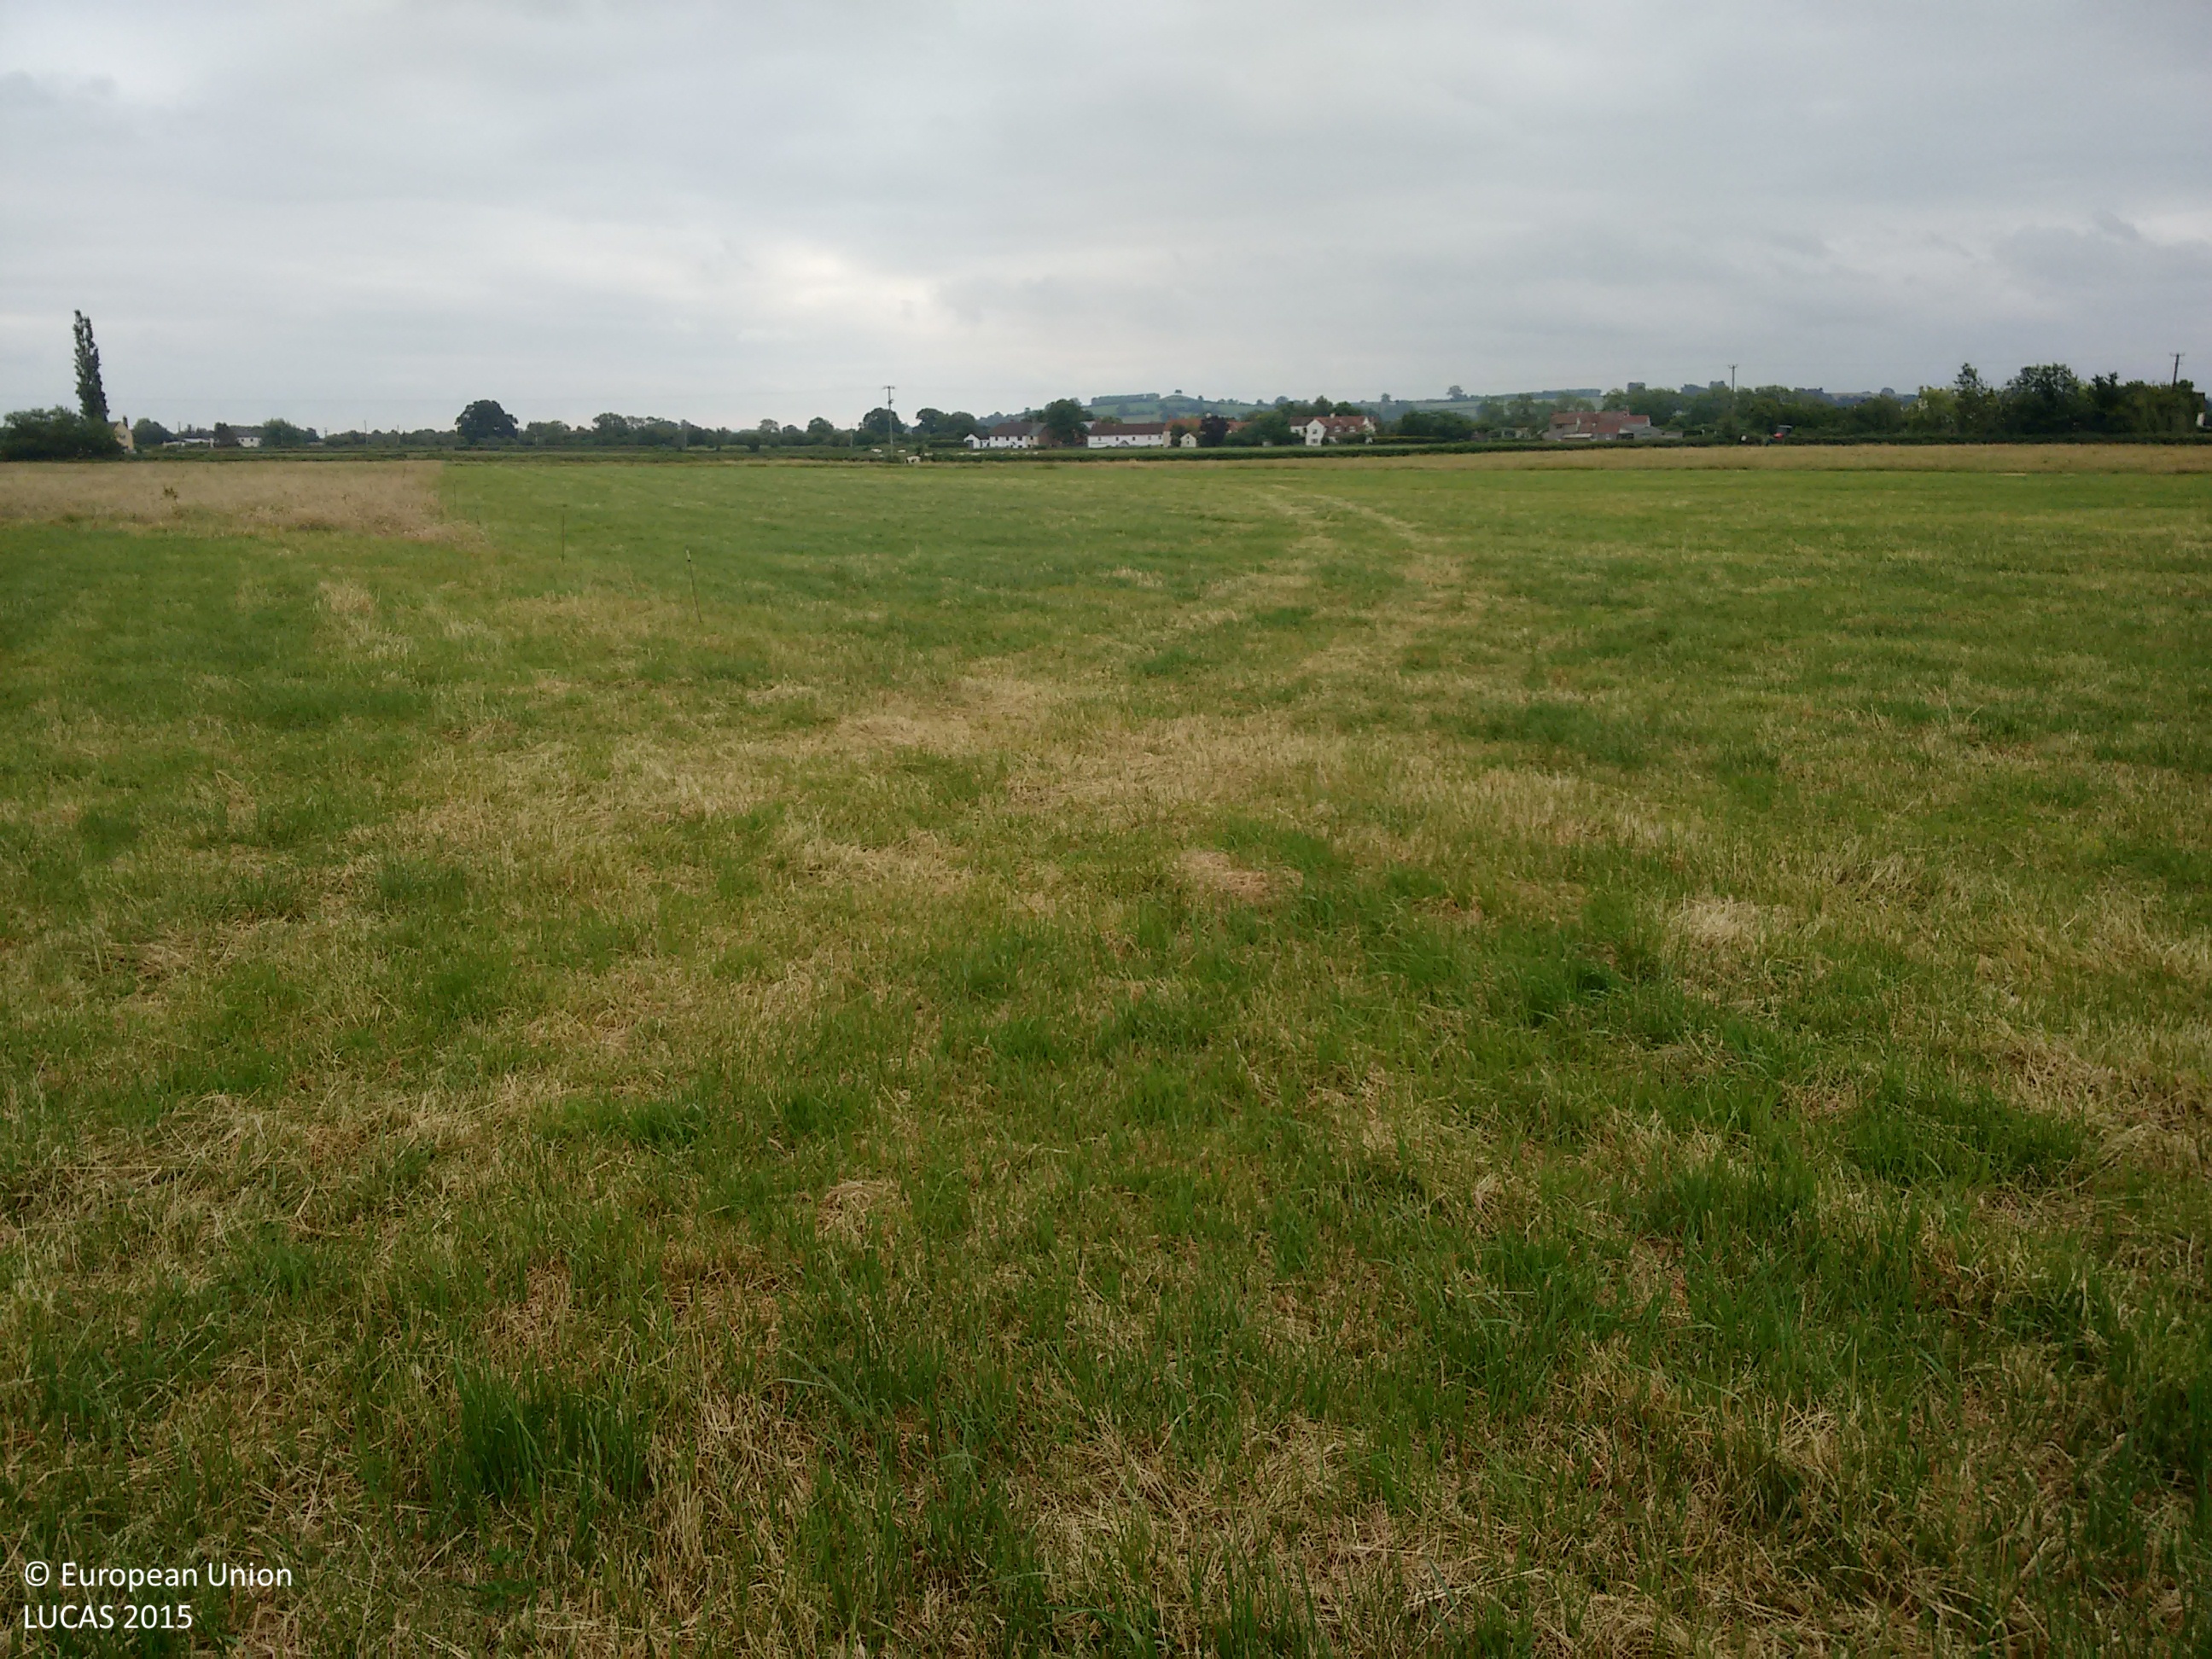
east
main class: Cropland
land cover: Temporary grasslands
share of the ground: > 75 %
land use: Agriculture (excluding fallow land and kitchen gardens)
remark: Harvested field
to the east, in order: Temporary grasslands; Spontaneously vegetated surfaces; Fences; Grassland without tree/shrub cover; Fences; Managed hedges; Electric lines; Managed hedges; Fences; Grassland without tree/shrub cover
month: June
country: GB
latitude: 50.9802
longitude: -2.8777
